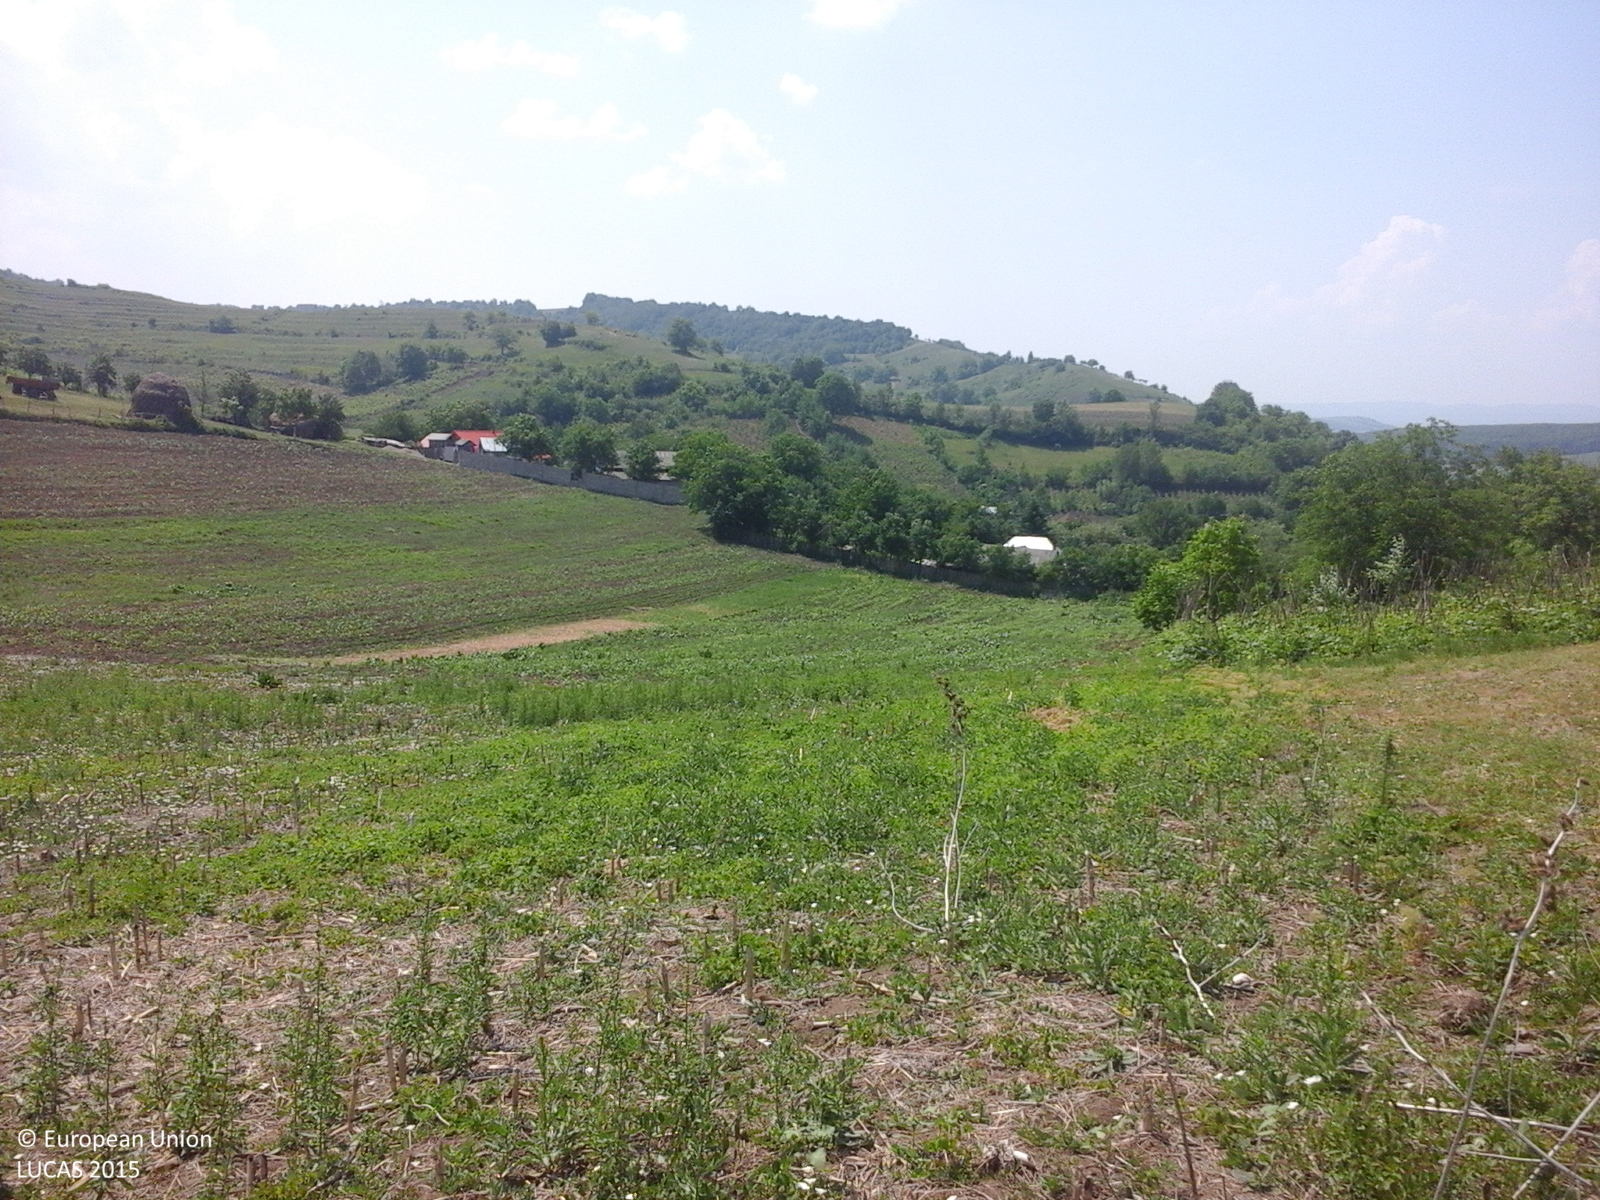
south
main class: Grassland
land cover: Spontaneously vegetated surfaces
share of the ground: > 75 %
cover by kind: herbaceous plants 100 %
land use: Agriculture (excluding fallow land and kitchen gardens)
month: June
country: RO
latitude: 46.3923
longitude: 27.1217
